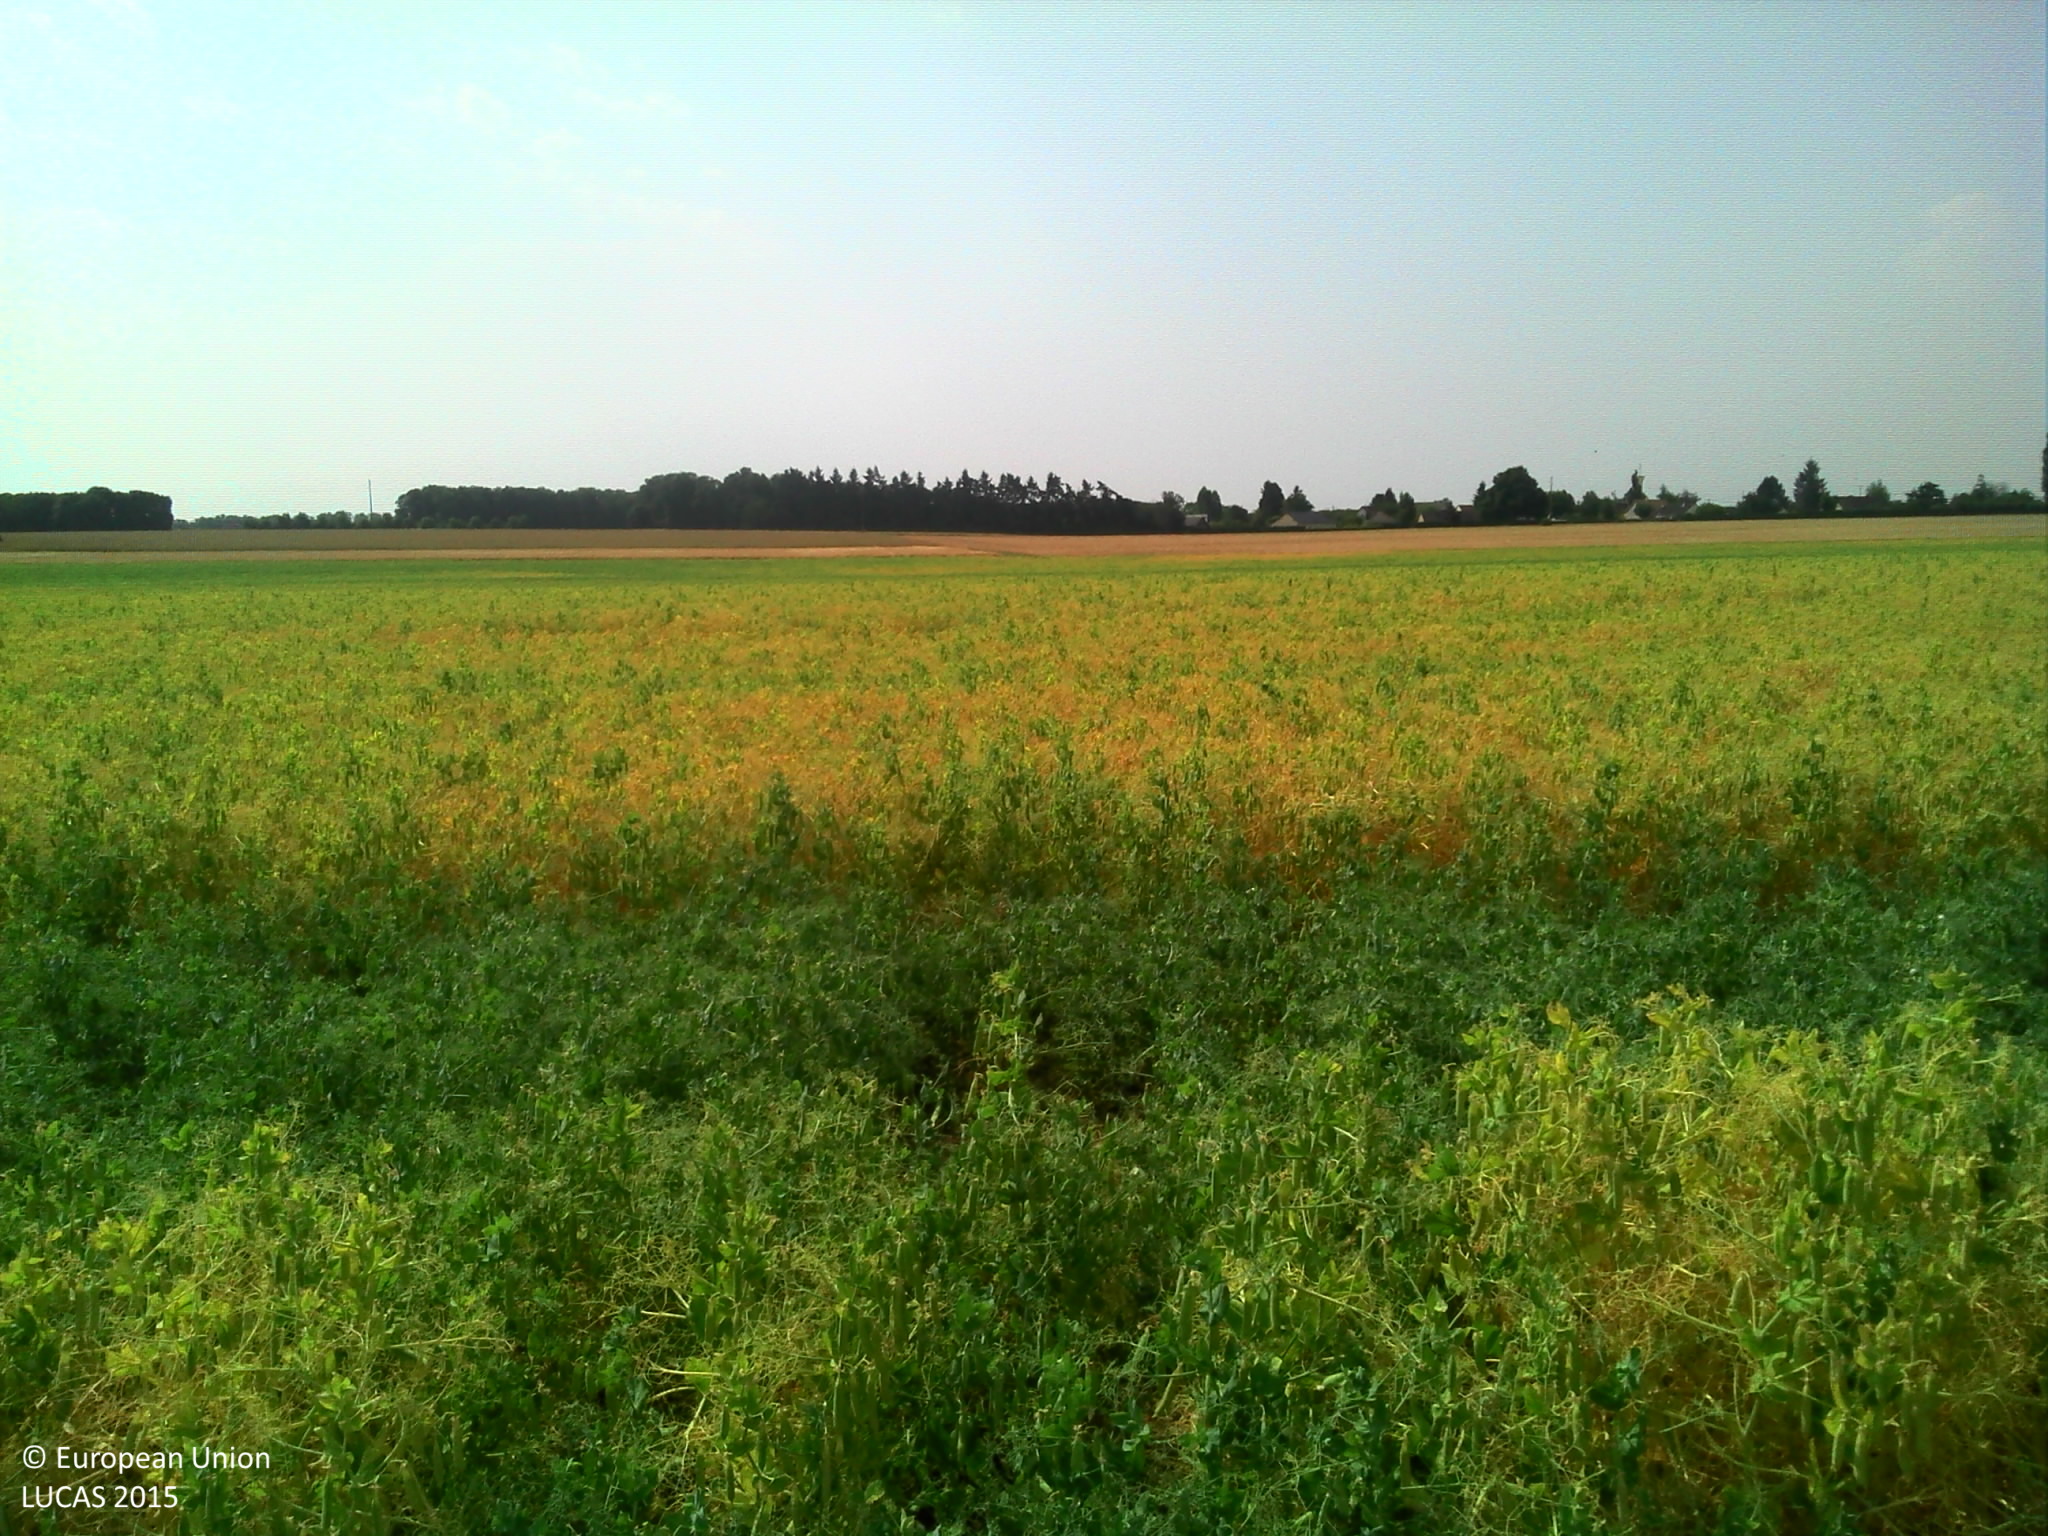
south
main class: Cropland
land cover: Dry pulses
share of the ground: > 75 %
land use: Agriculture (excluding fallow land and kitchen gardens)
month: July
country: FR
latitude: 48.8876
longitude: 1.2384
